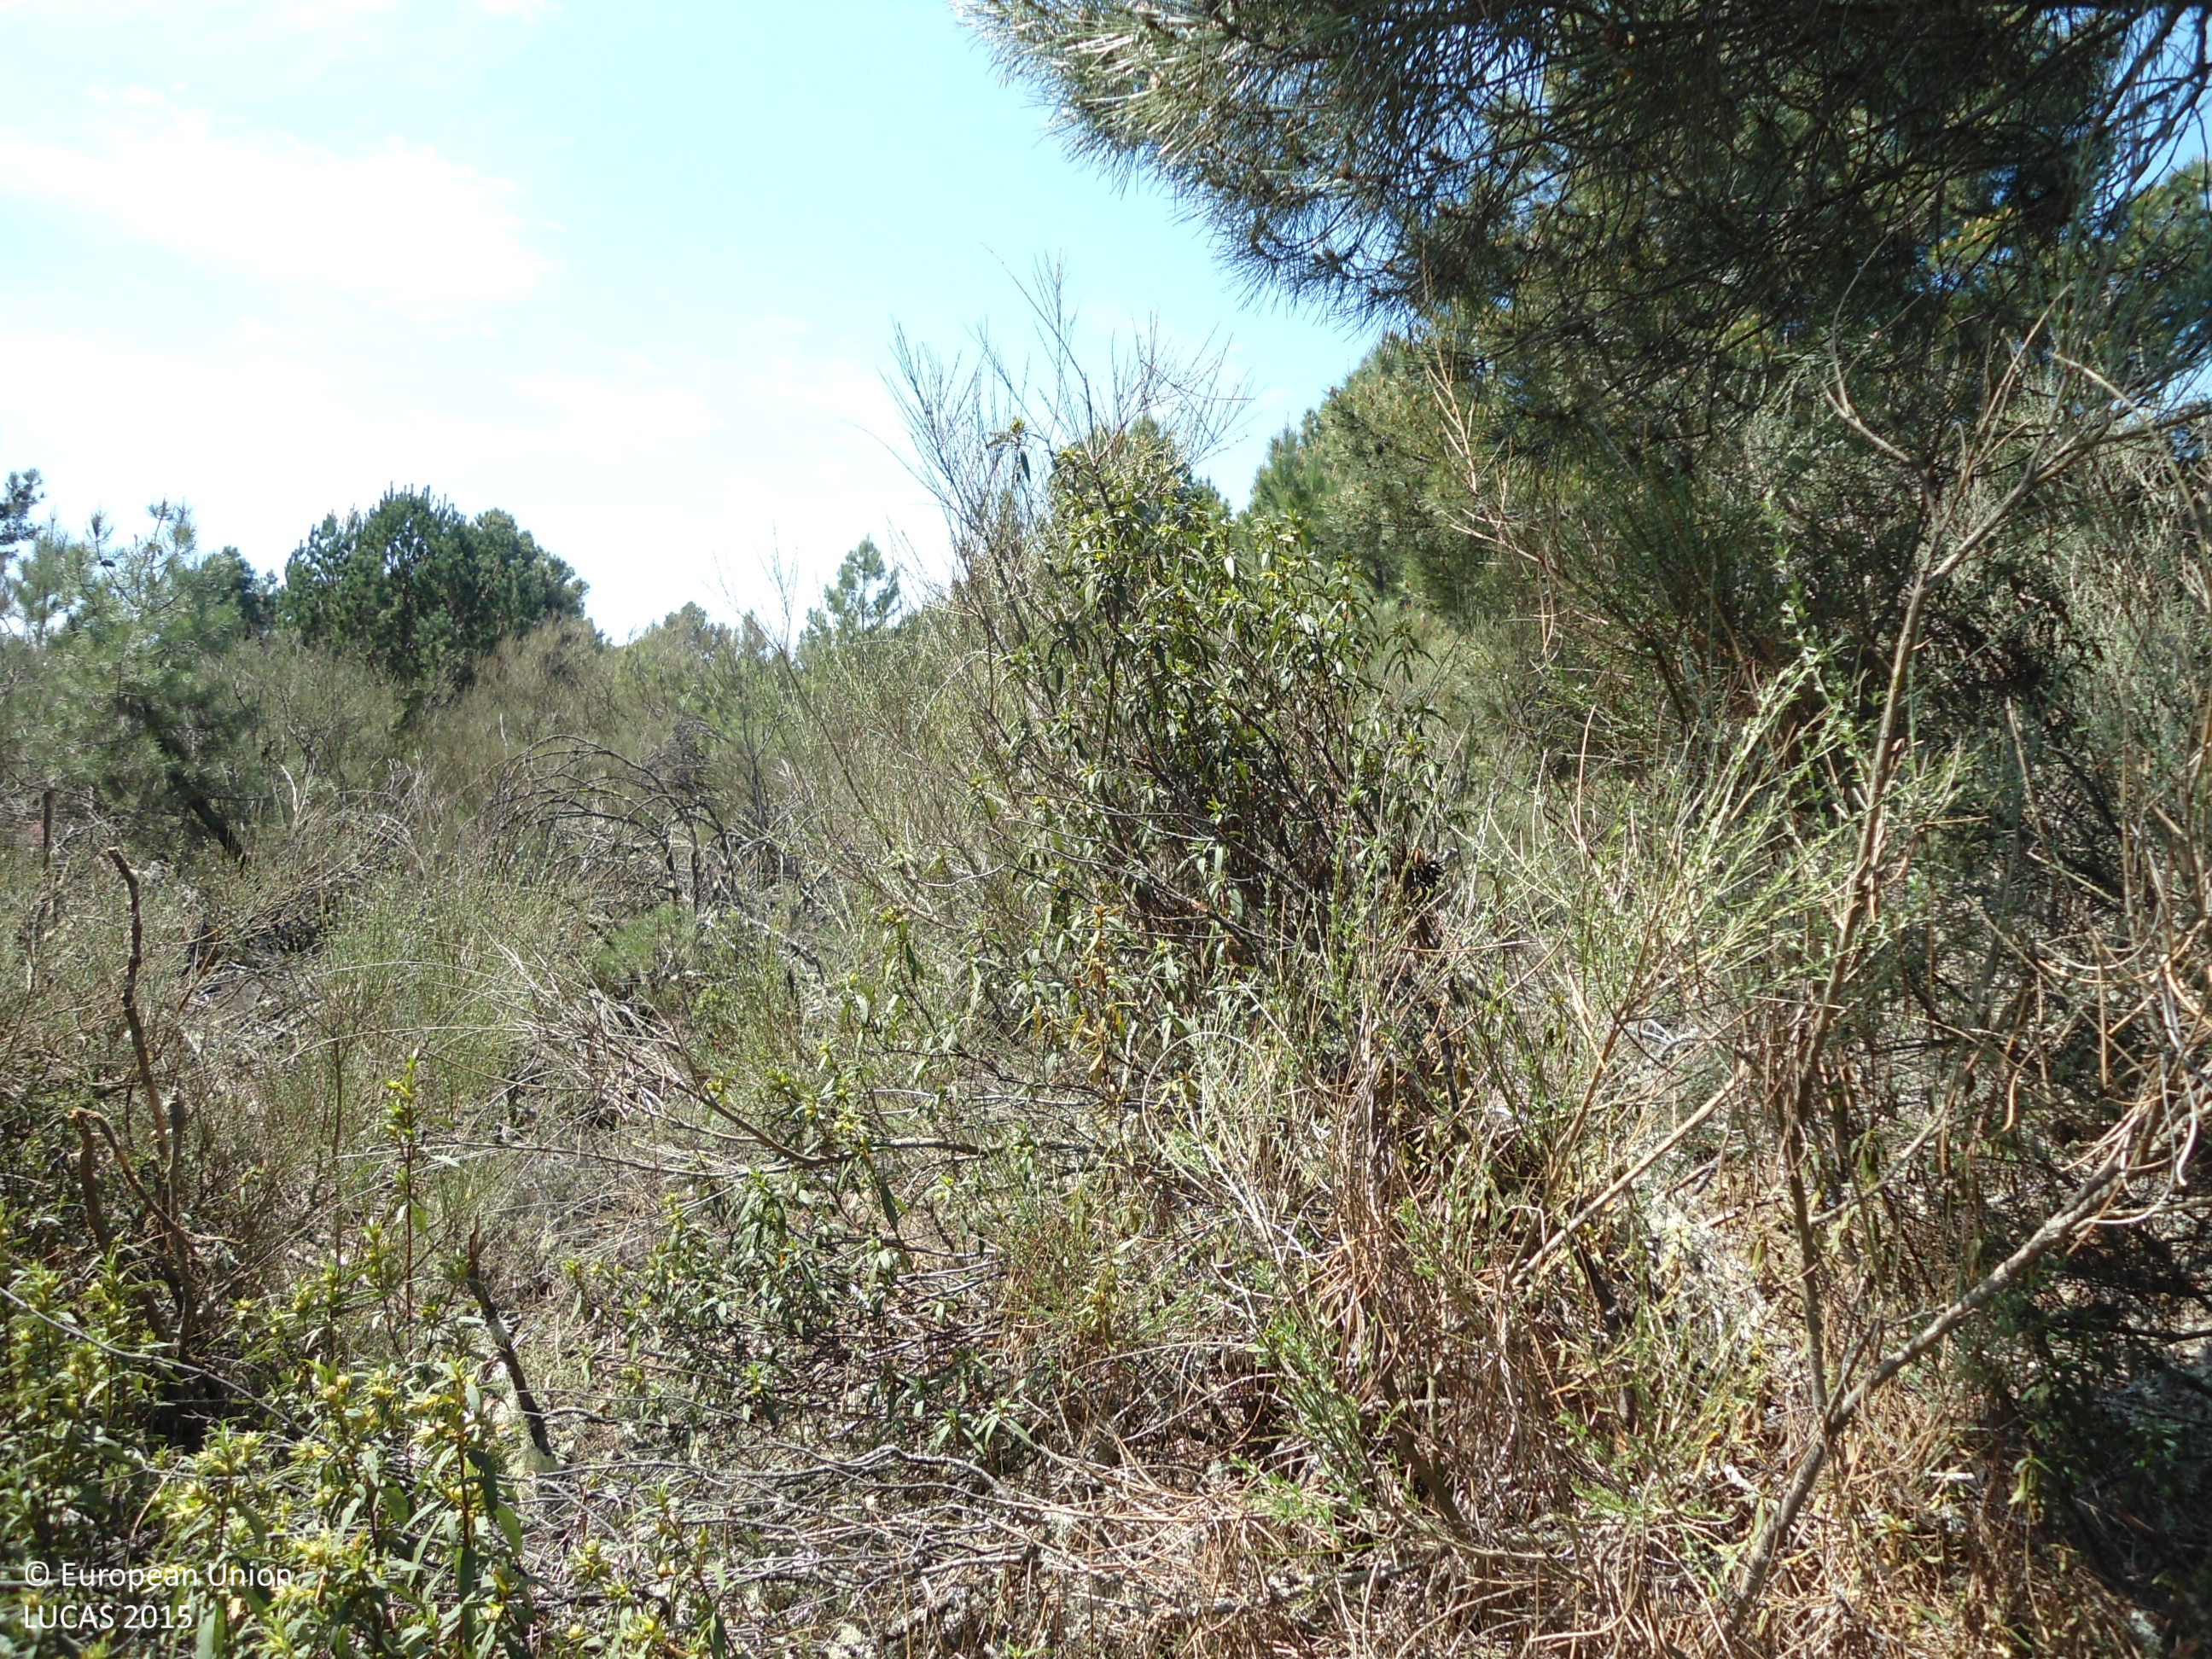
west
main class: Woodland
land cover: Pine dominated coniferous woodland
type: coniferous forest of the mediterranean region
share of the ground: > 75 %
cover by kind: coniferous forest trees 85 %, shrubs 15 %
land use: Forestry
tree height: < 5 m
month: April
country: ES
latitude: 41.8596
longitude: -6.2811
